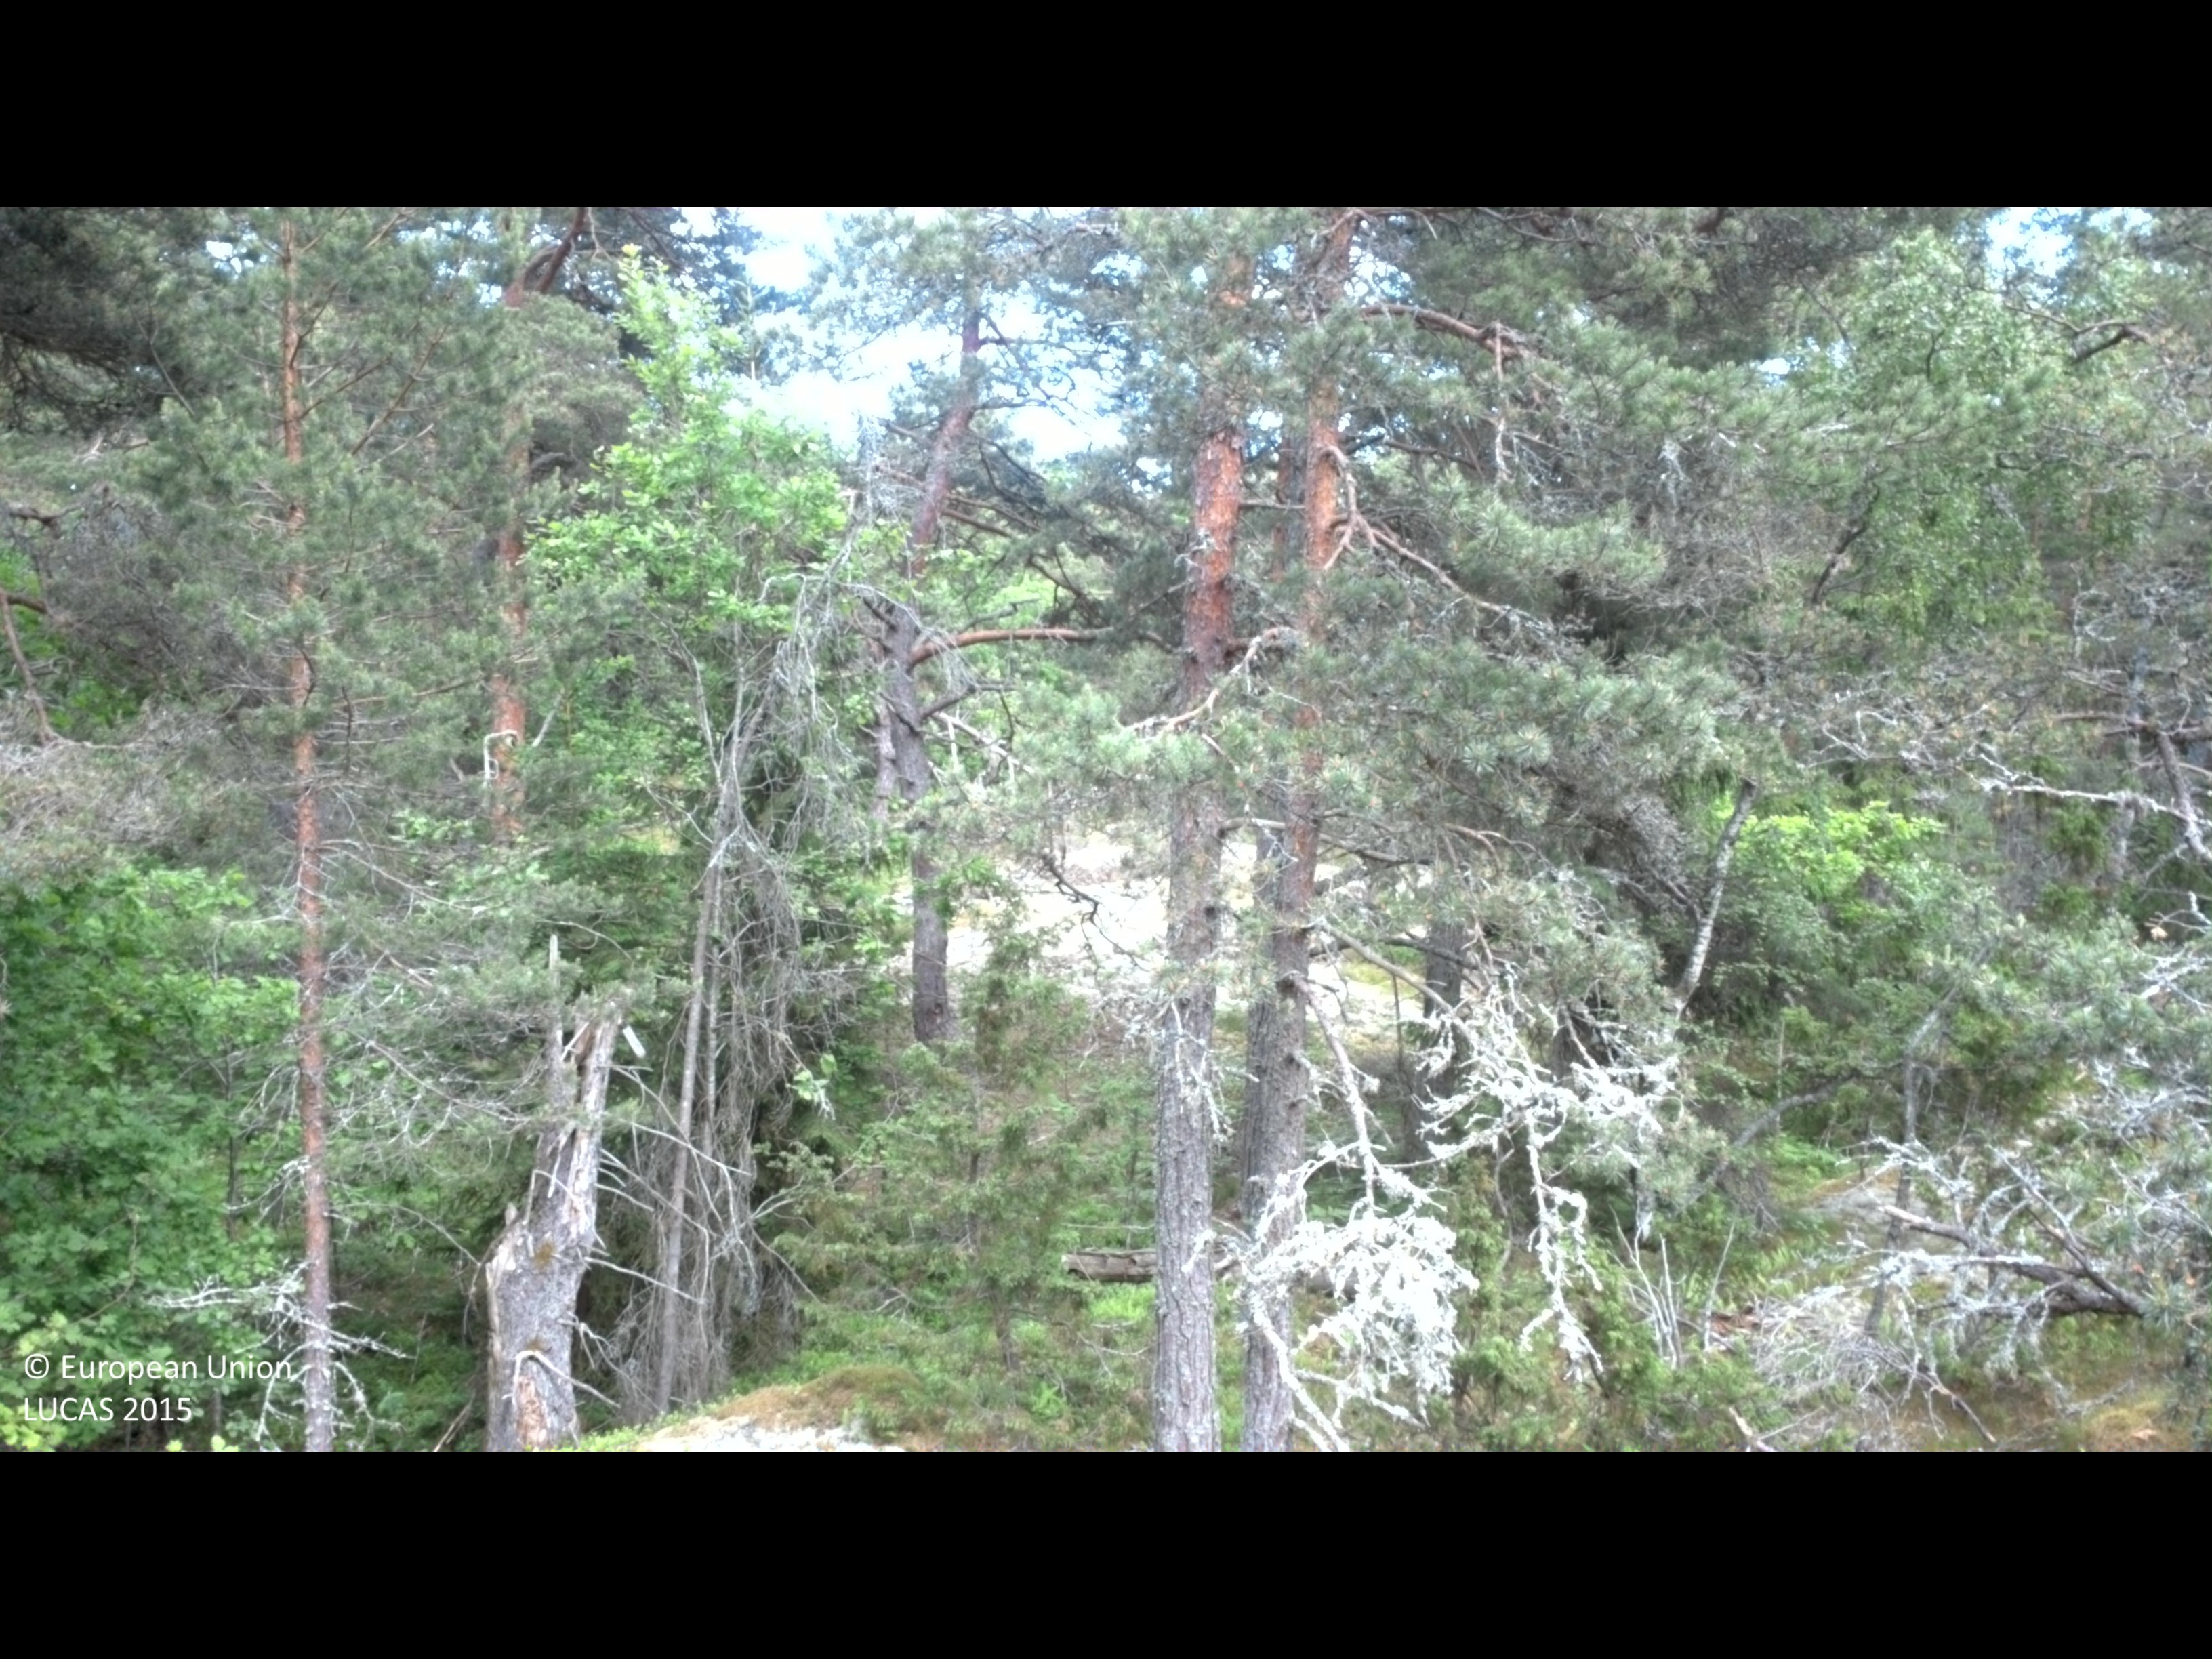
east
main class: Woodland
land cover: Pine dominated mixed woodland
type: hemiboreal forest and nemoral coniferous forest and mixed broadleaved-coniferous forest
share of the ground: 25 - 50 %
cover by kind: lichens and mosses 35 %, coniferous forest trees 30 %, broadleaved forest trees 20 %, unconsolidated bare surface 10 %, shrubs 5 %
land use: Forestry
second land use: Amenities, museums, leisure
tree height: > 5 m
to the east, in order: Pine dominated mixed woodland; Tracks; Broadleaved woodland; Pine dominated mixed woodland; Tracks; Broadleaved woodland; Artificial constructions in urban areas; Shrubland with sparse tree cover; Rocks and stones
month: June
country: SE
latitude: 57.7274
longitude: 16.6991
